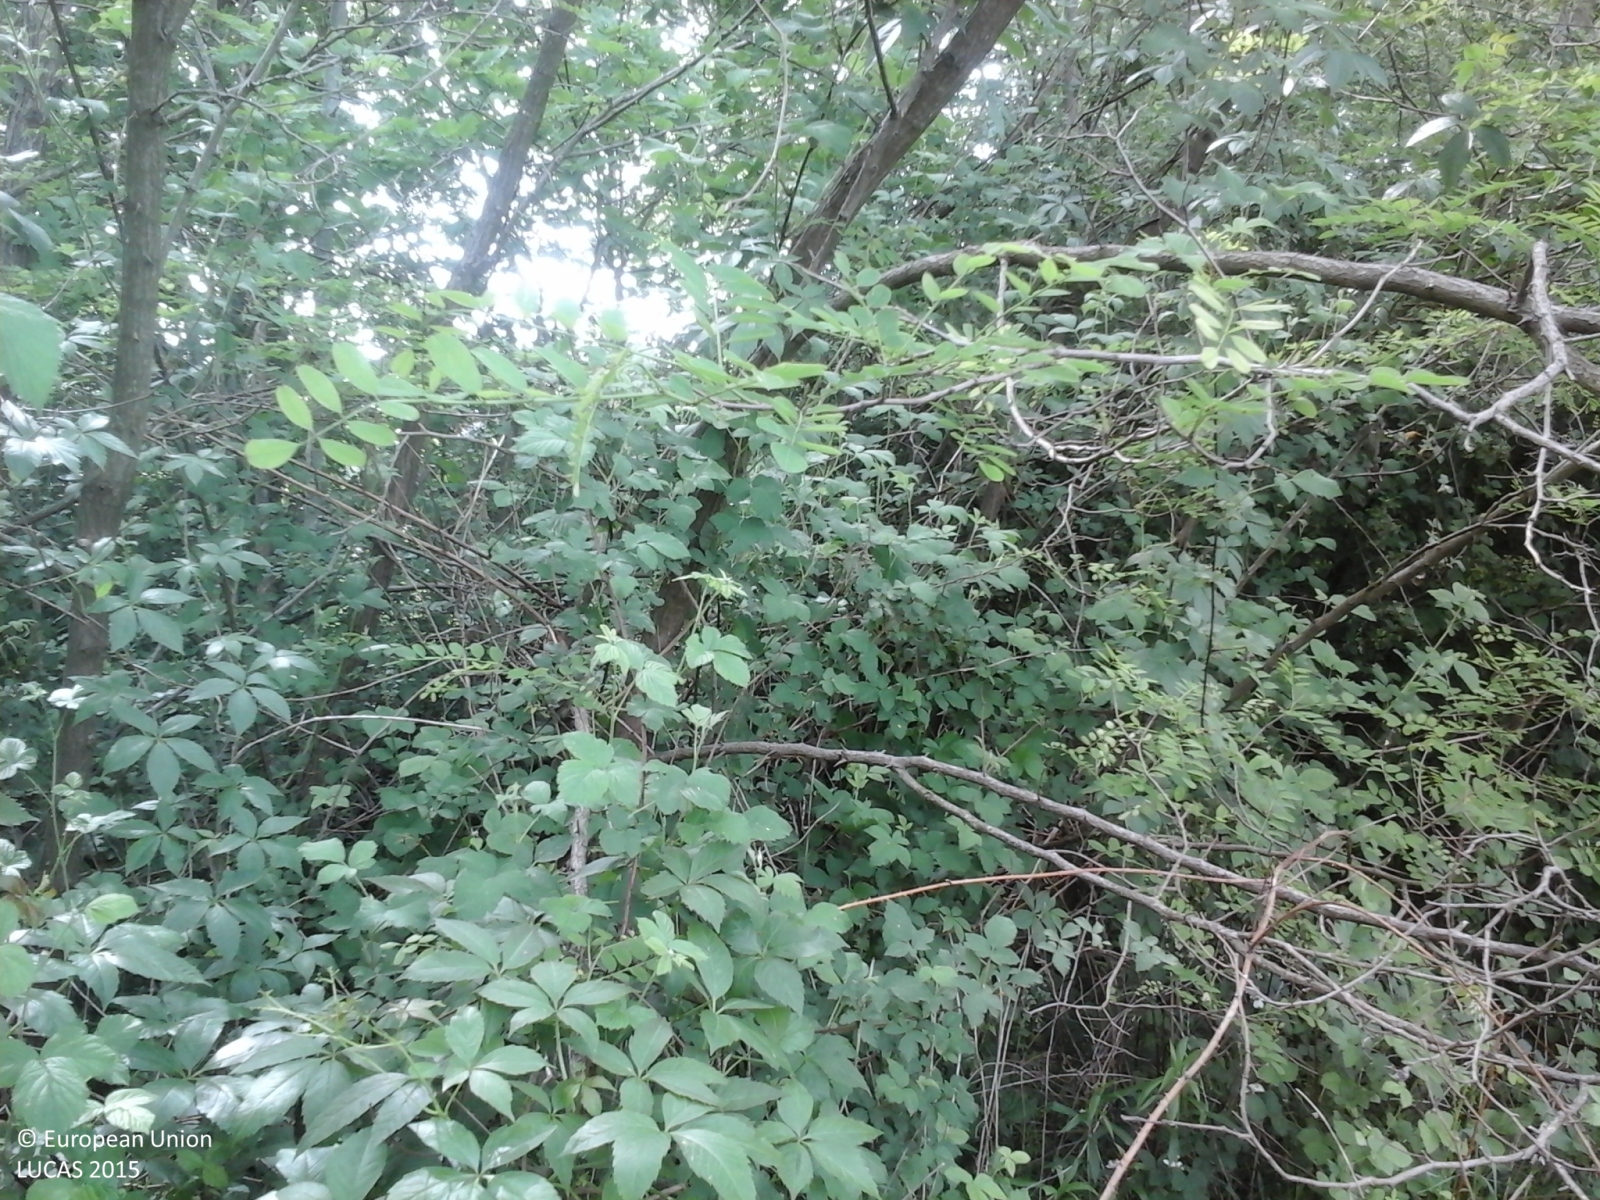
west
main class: Grassland
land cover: Grassland without tree/shrub cover
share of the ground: > 75 %
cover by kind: herbaceous plants 100 %
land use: Agriculture (excluding fallow land and kitchen gardens)
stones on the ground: < 10 %
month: May
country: IT
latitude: 45.6541
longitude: 8.3728
